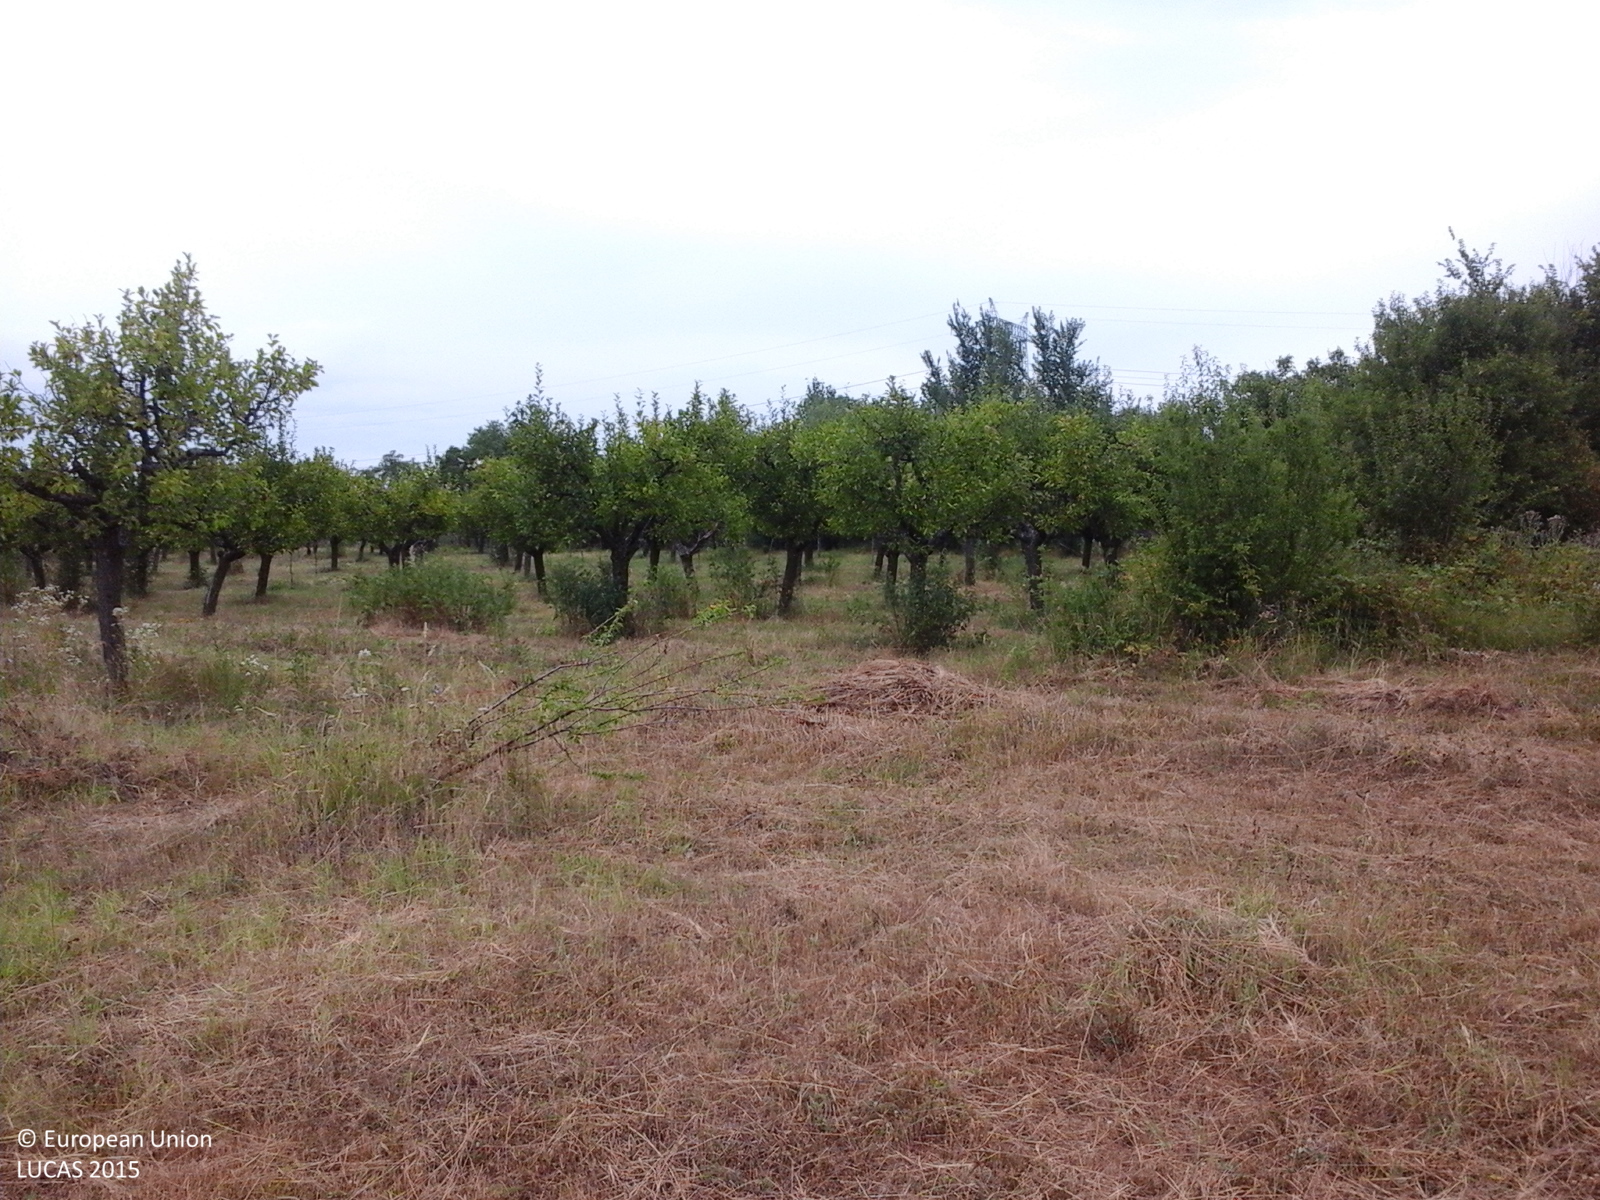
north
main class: Cropland
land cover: Other fruit trees and berries
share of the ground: > 75 %
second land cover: Grassland without tree/shrub cover
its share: > 75 %
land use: Agriculture (excluding fallow land and kitchen gardens)
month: July
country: RO
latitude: 44.8007
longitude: 24.4210
